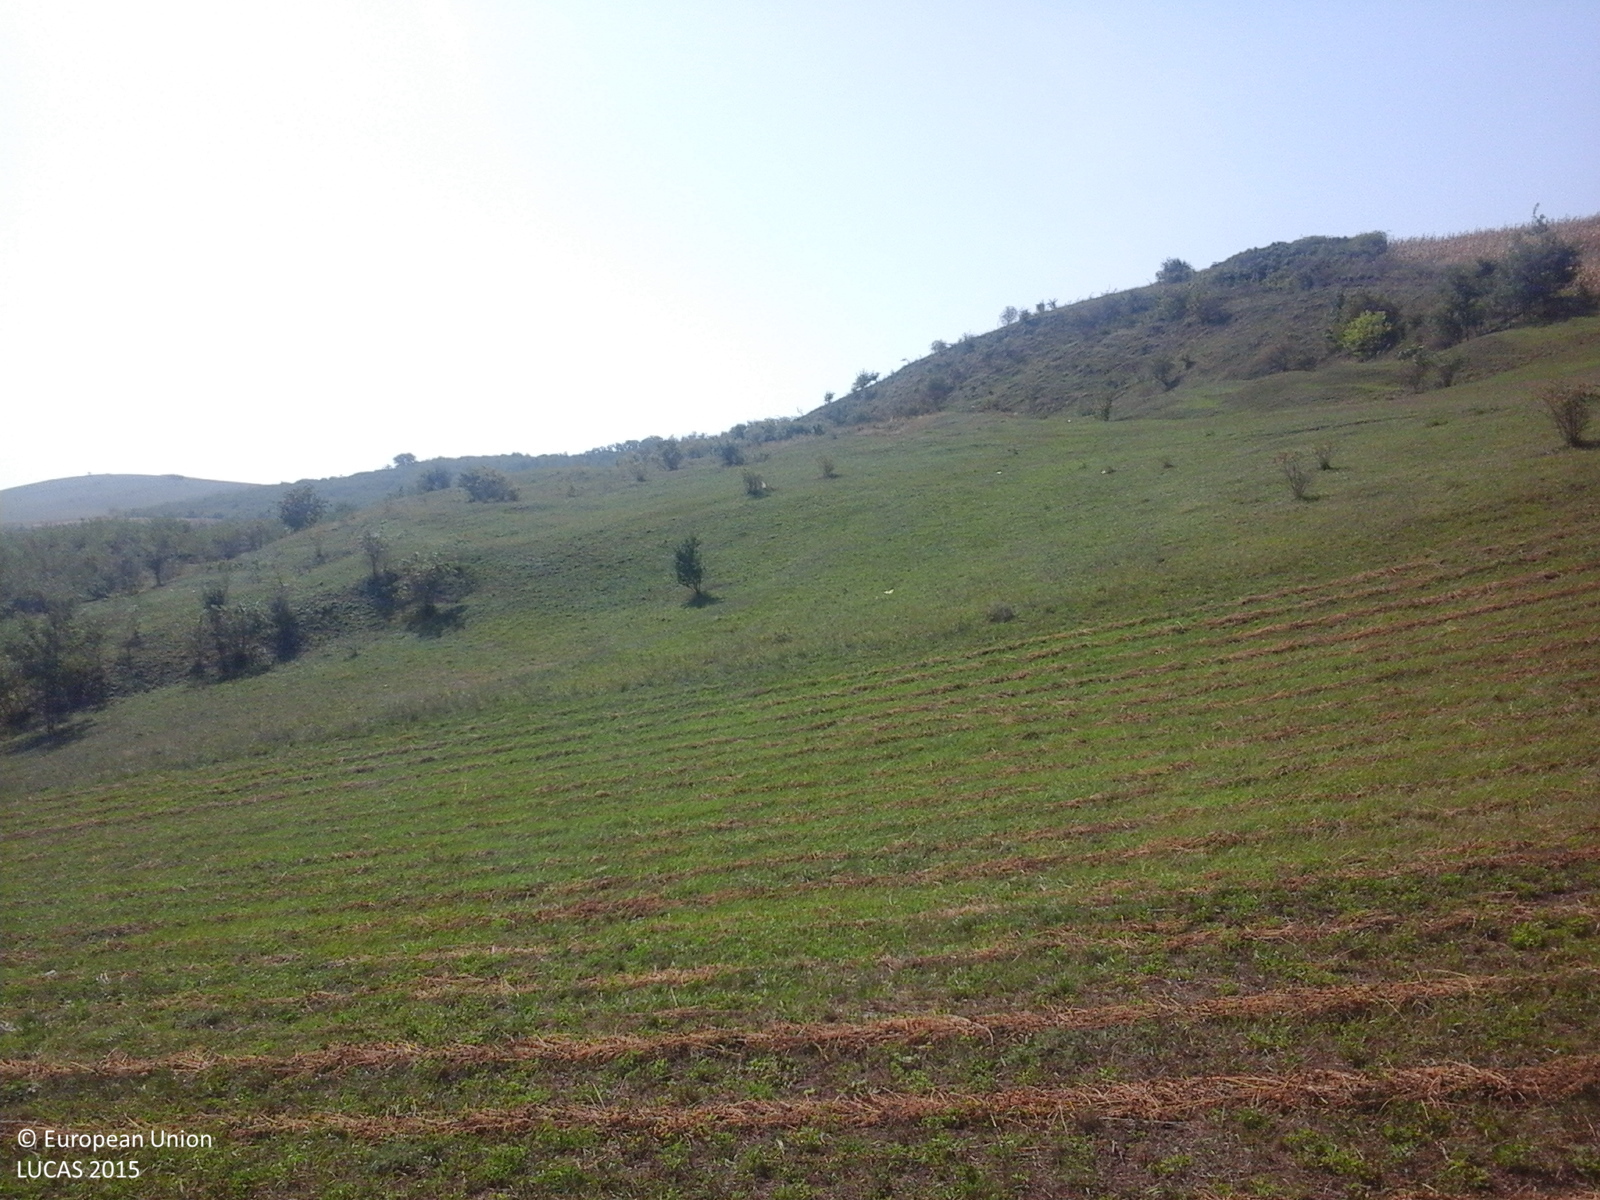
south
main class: Cropland
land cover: Lucerne
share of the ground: > 75 %
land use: Agriculture (excluding fallow land and kitchen gardens)
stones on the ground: < 10 %
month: September
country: RO
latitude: 46.6538
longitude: 24.1009
